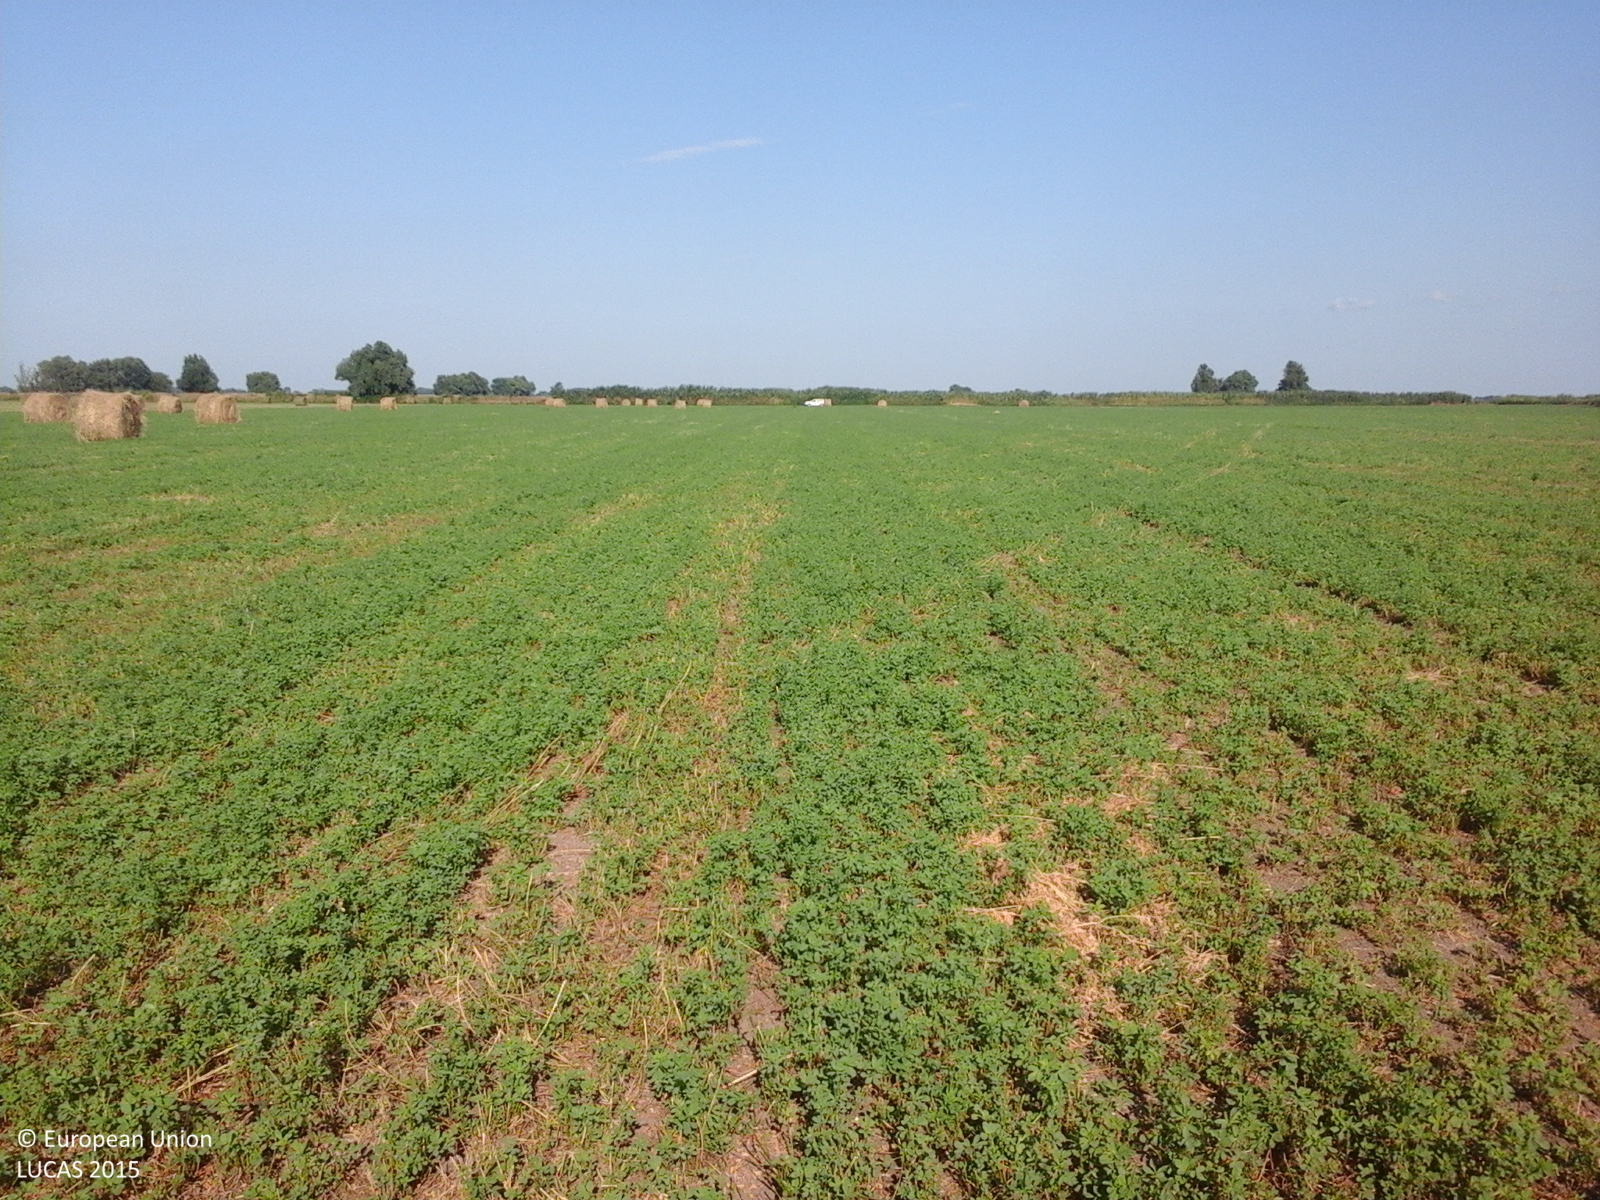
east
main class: Cropland
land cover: Lucerne
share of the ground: > 75 %
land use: Agriculture (excluding fallow land and kitchen gardens)
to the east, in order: Lucerne
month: August
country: RO
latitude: 45.3509
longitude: 29.1875
